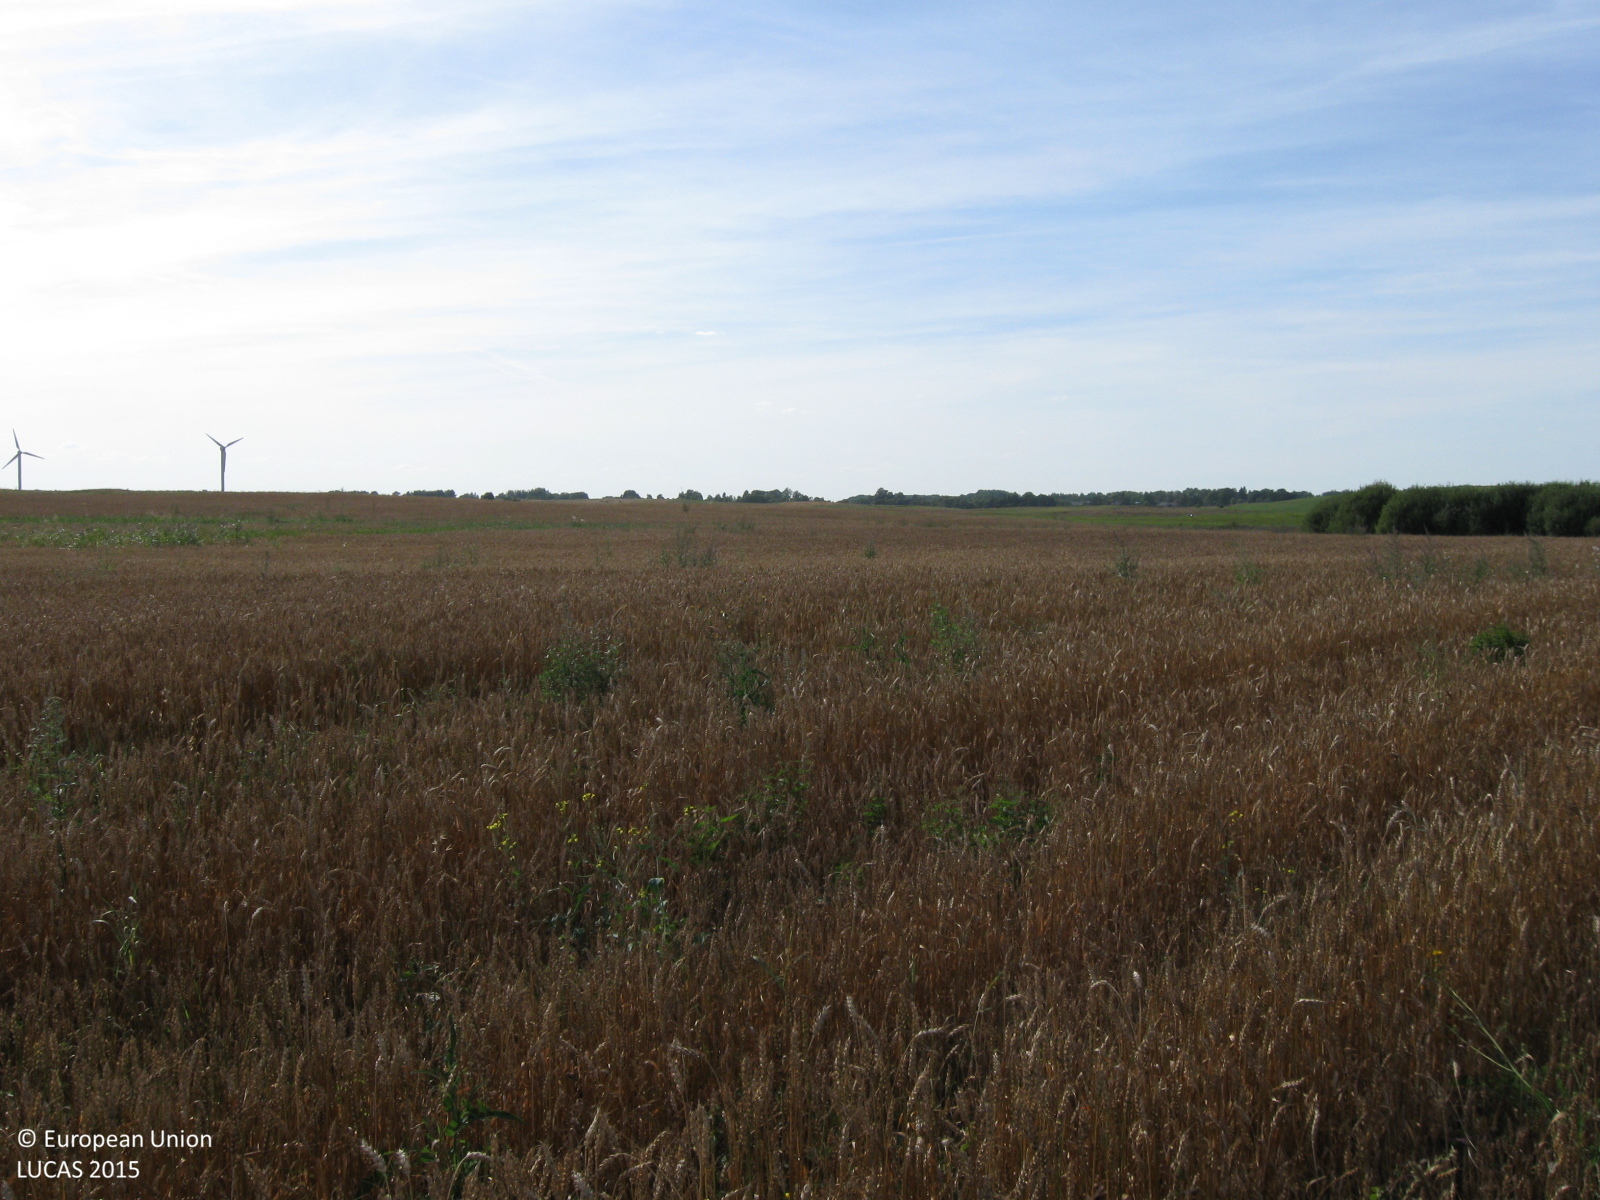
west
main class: Cropland
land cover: Common wheat
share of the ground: > 75 %
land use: Agriculture (excluding fallow land and kitchen gardens)
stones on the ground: < 10 %
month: August
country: LT
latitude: 55.4956
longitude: 22.5509
